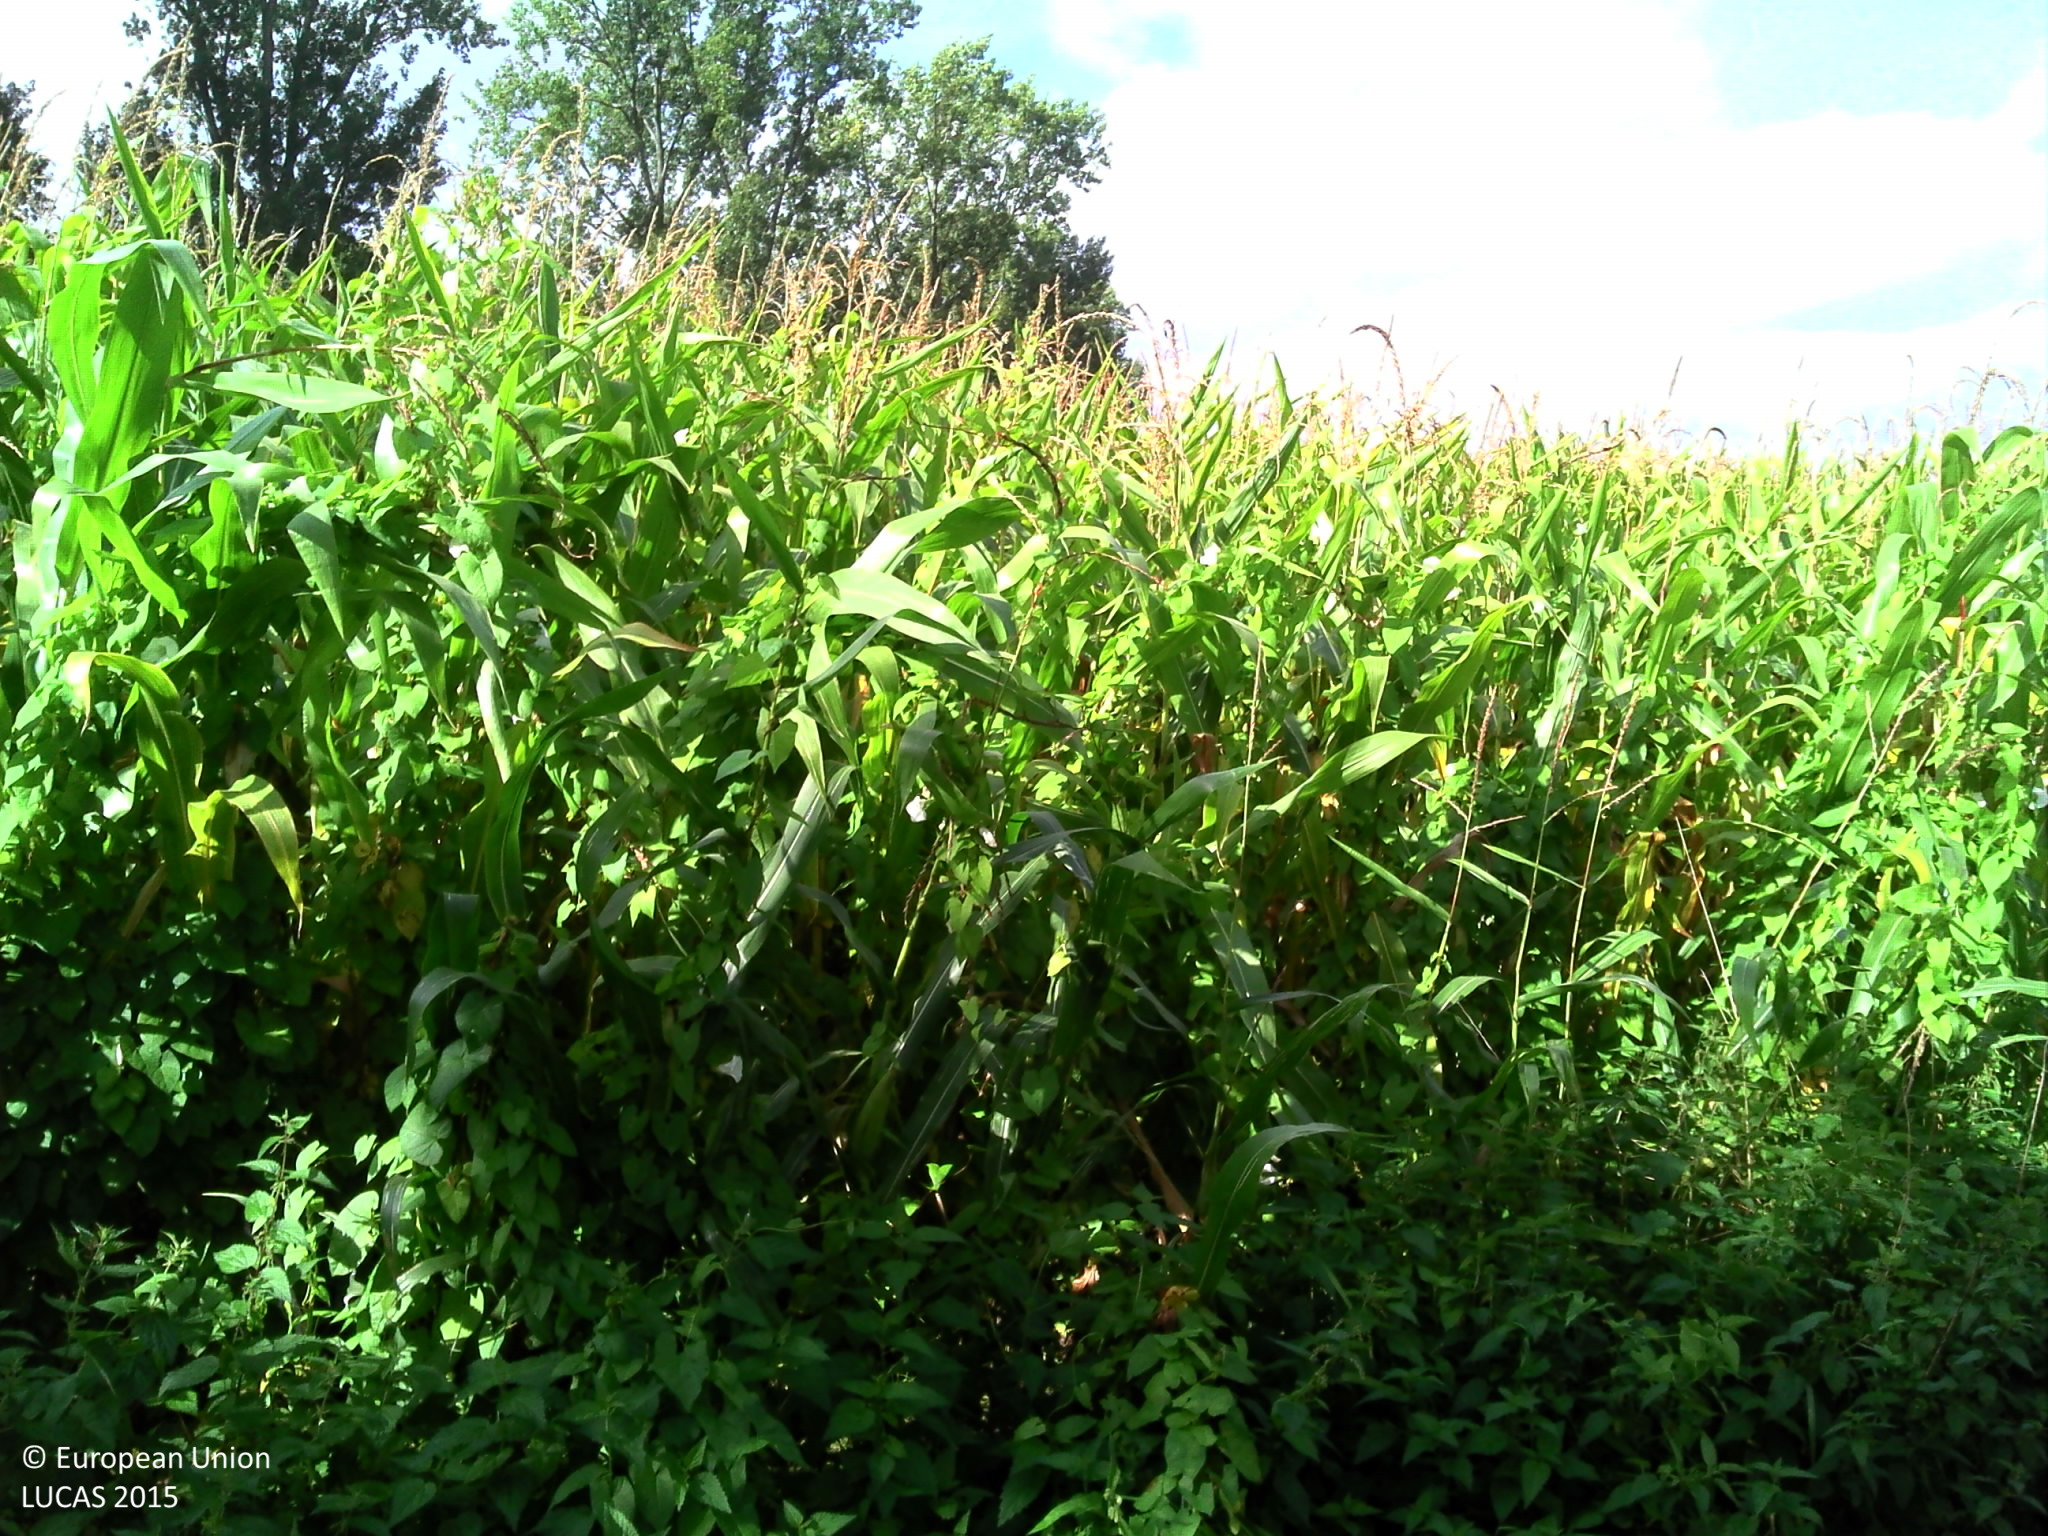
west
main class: Cropland
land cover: Maize
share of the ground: > 75 %
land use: Agriculture (excluding fallow land and kitchen gardens)
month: September
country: BE
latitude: 51.1464
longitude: 4.4062
